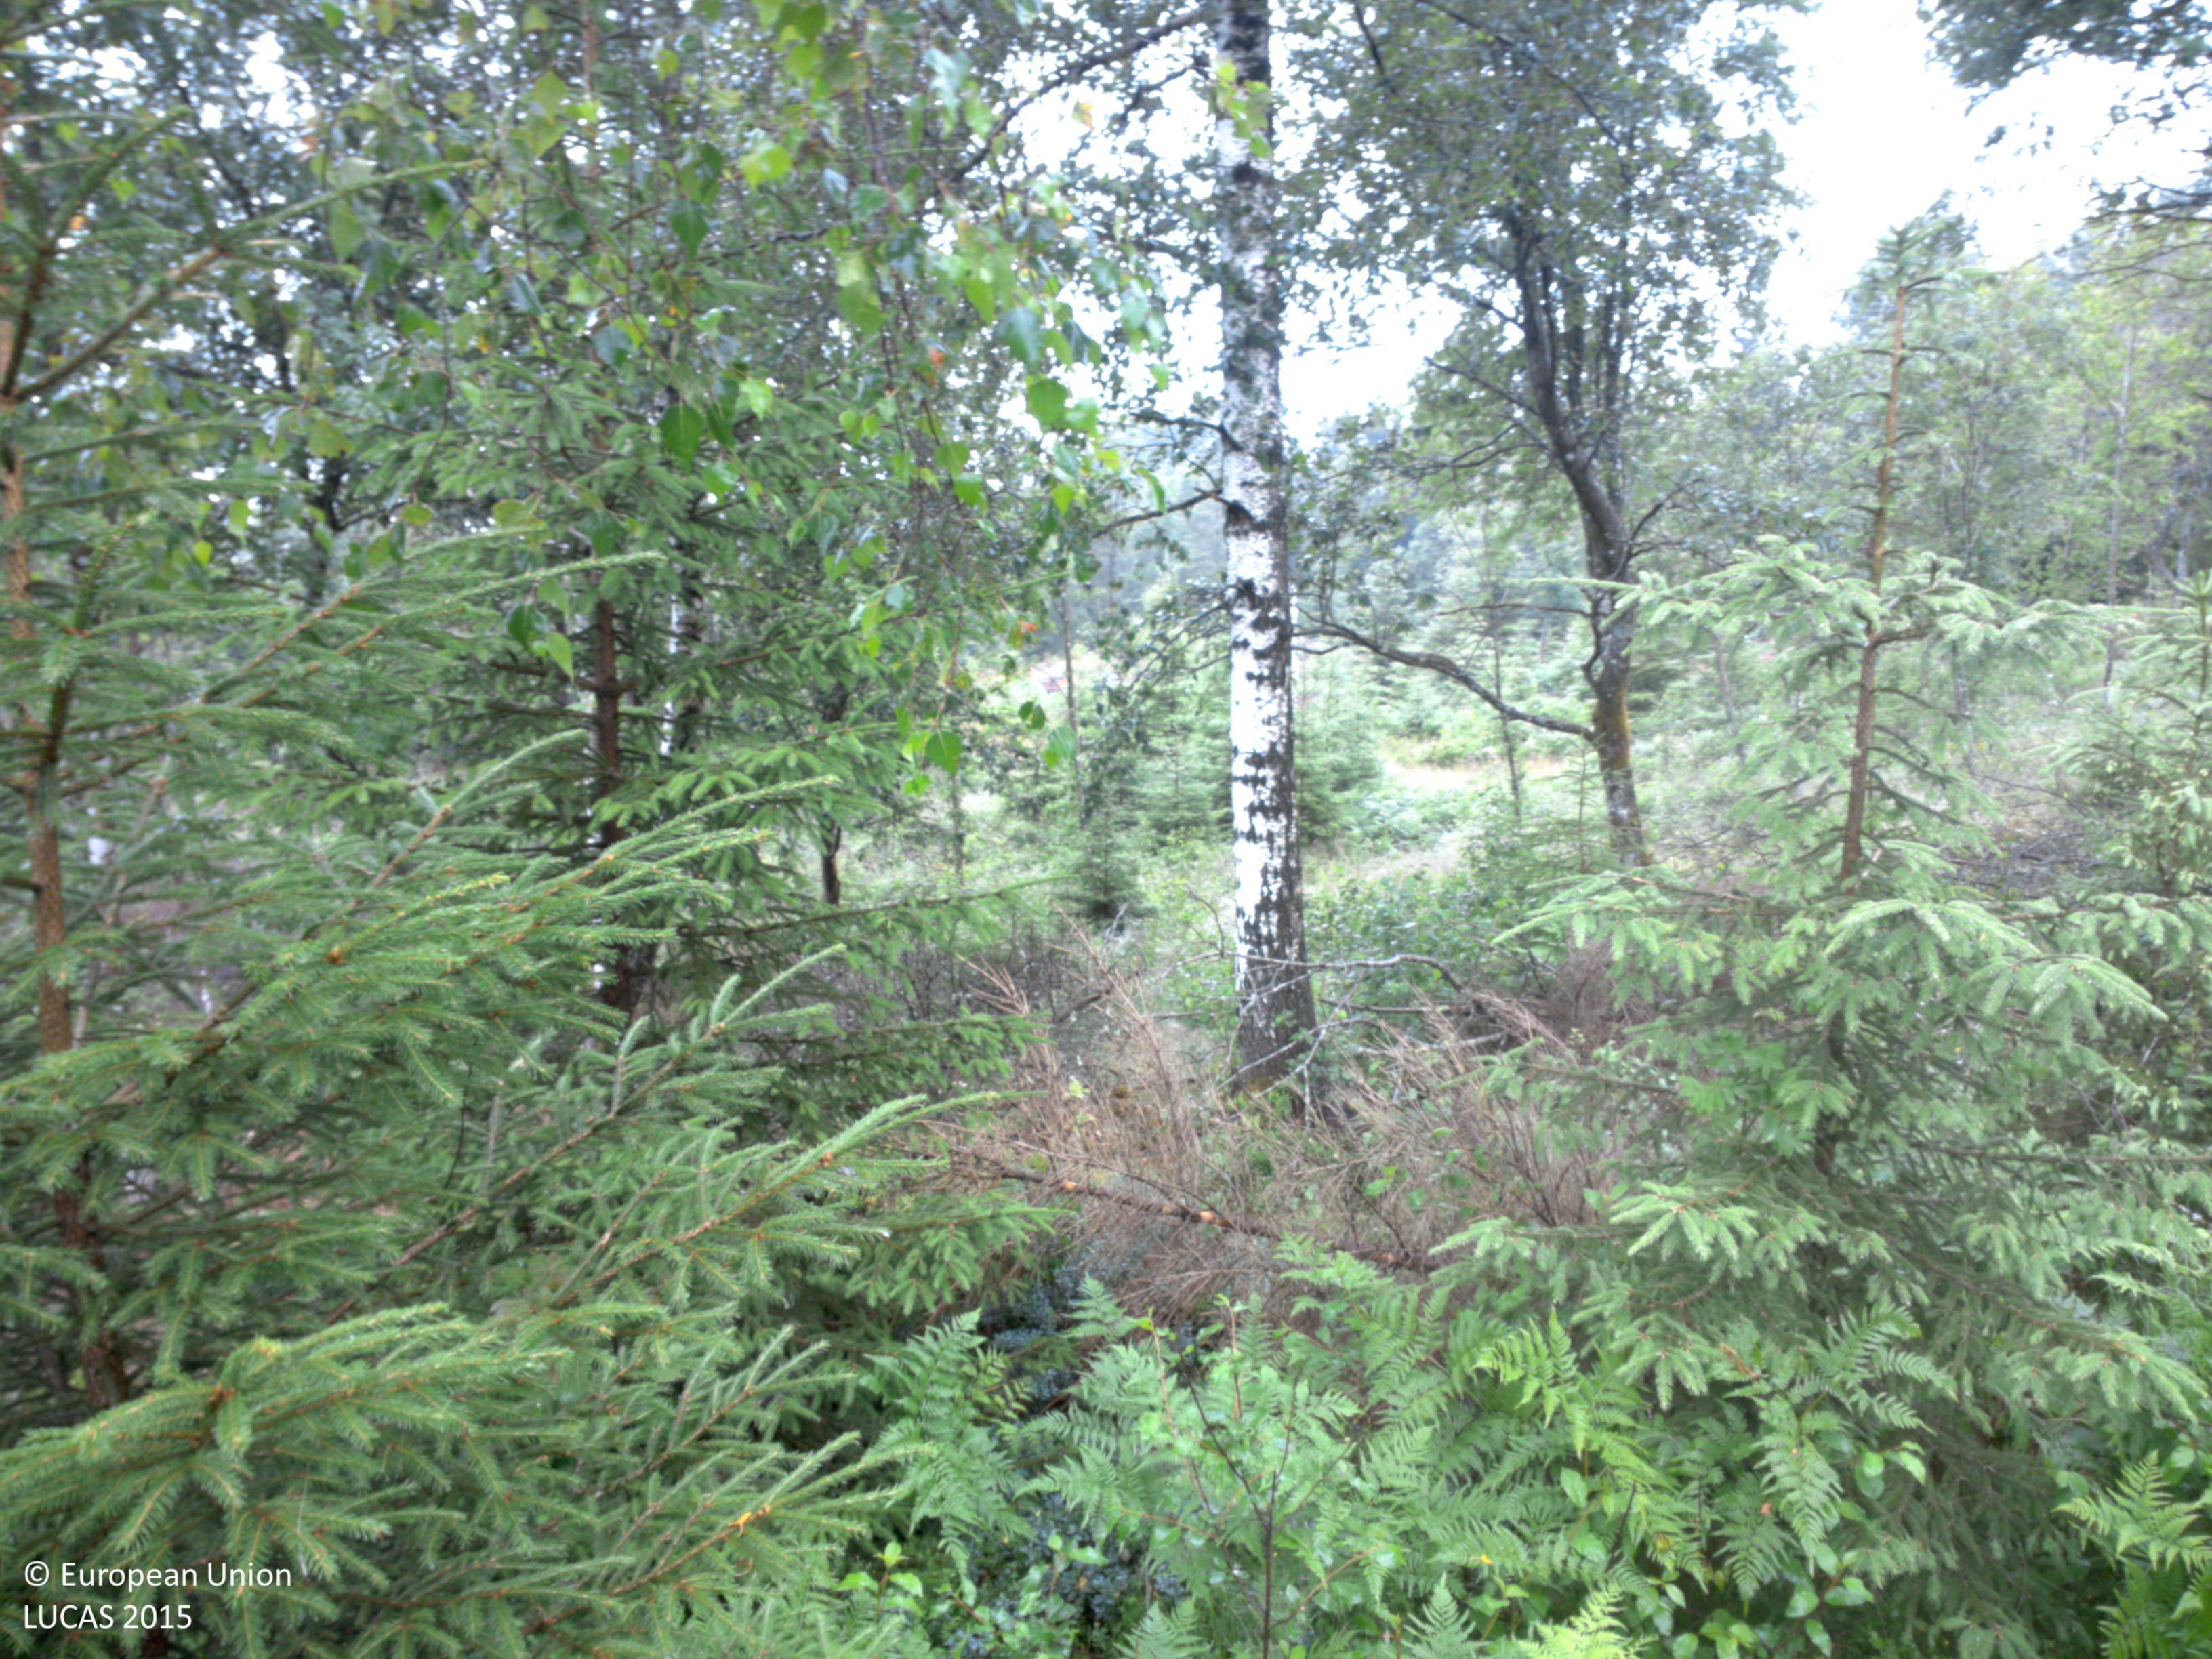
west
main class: Woodland
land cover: Spruce dominated mixed woodland
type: boreal forest
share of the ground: 50 - 75 %
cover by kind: coniferous forest trees 30 %, broadleaved forest trees 30 %, herbaceous plants 30 %, shrubs 10 %
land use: Forestry
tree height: > 5 m
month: July
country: SE
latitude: 58.6751
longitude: 11.8068
